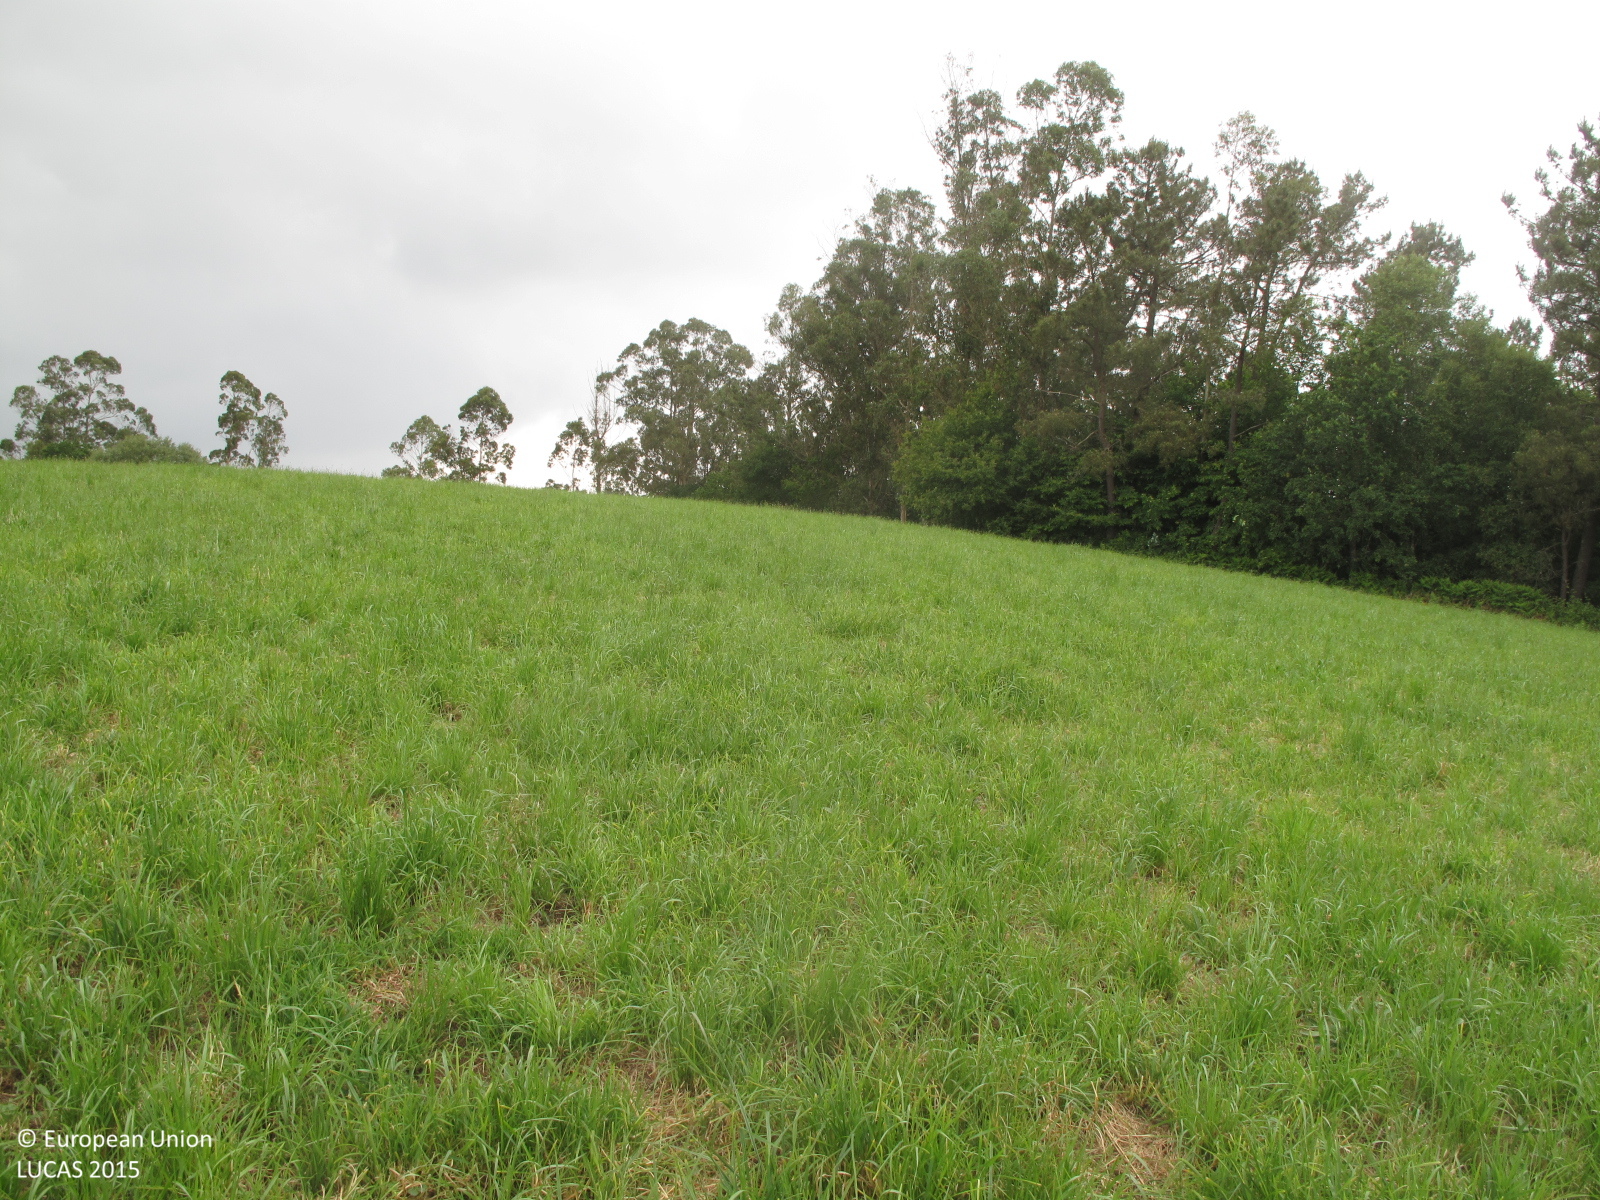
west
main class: Grassland
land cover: Grassland without tree/shrub cover
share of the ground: > 75 %
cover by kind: herbaceous plants 100 %
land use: Agriculture (excluding fallow land and kitchen gardens)
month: June
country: ES
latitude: 43.1508
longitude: -8.5921
